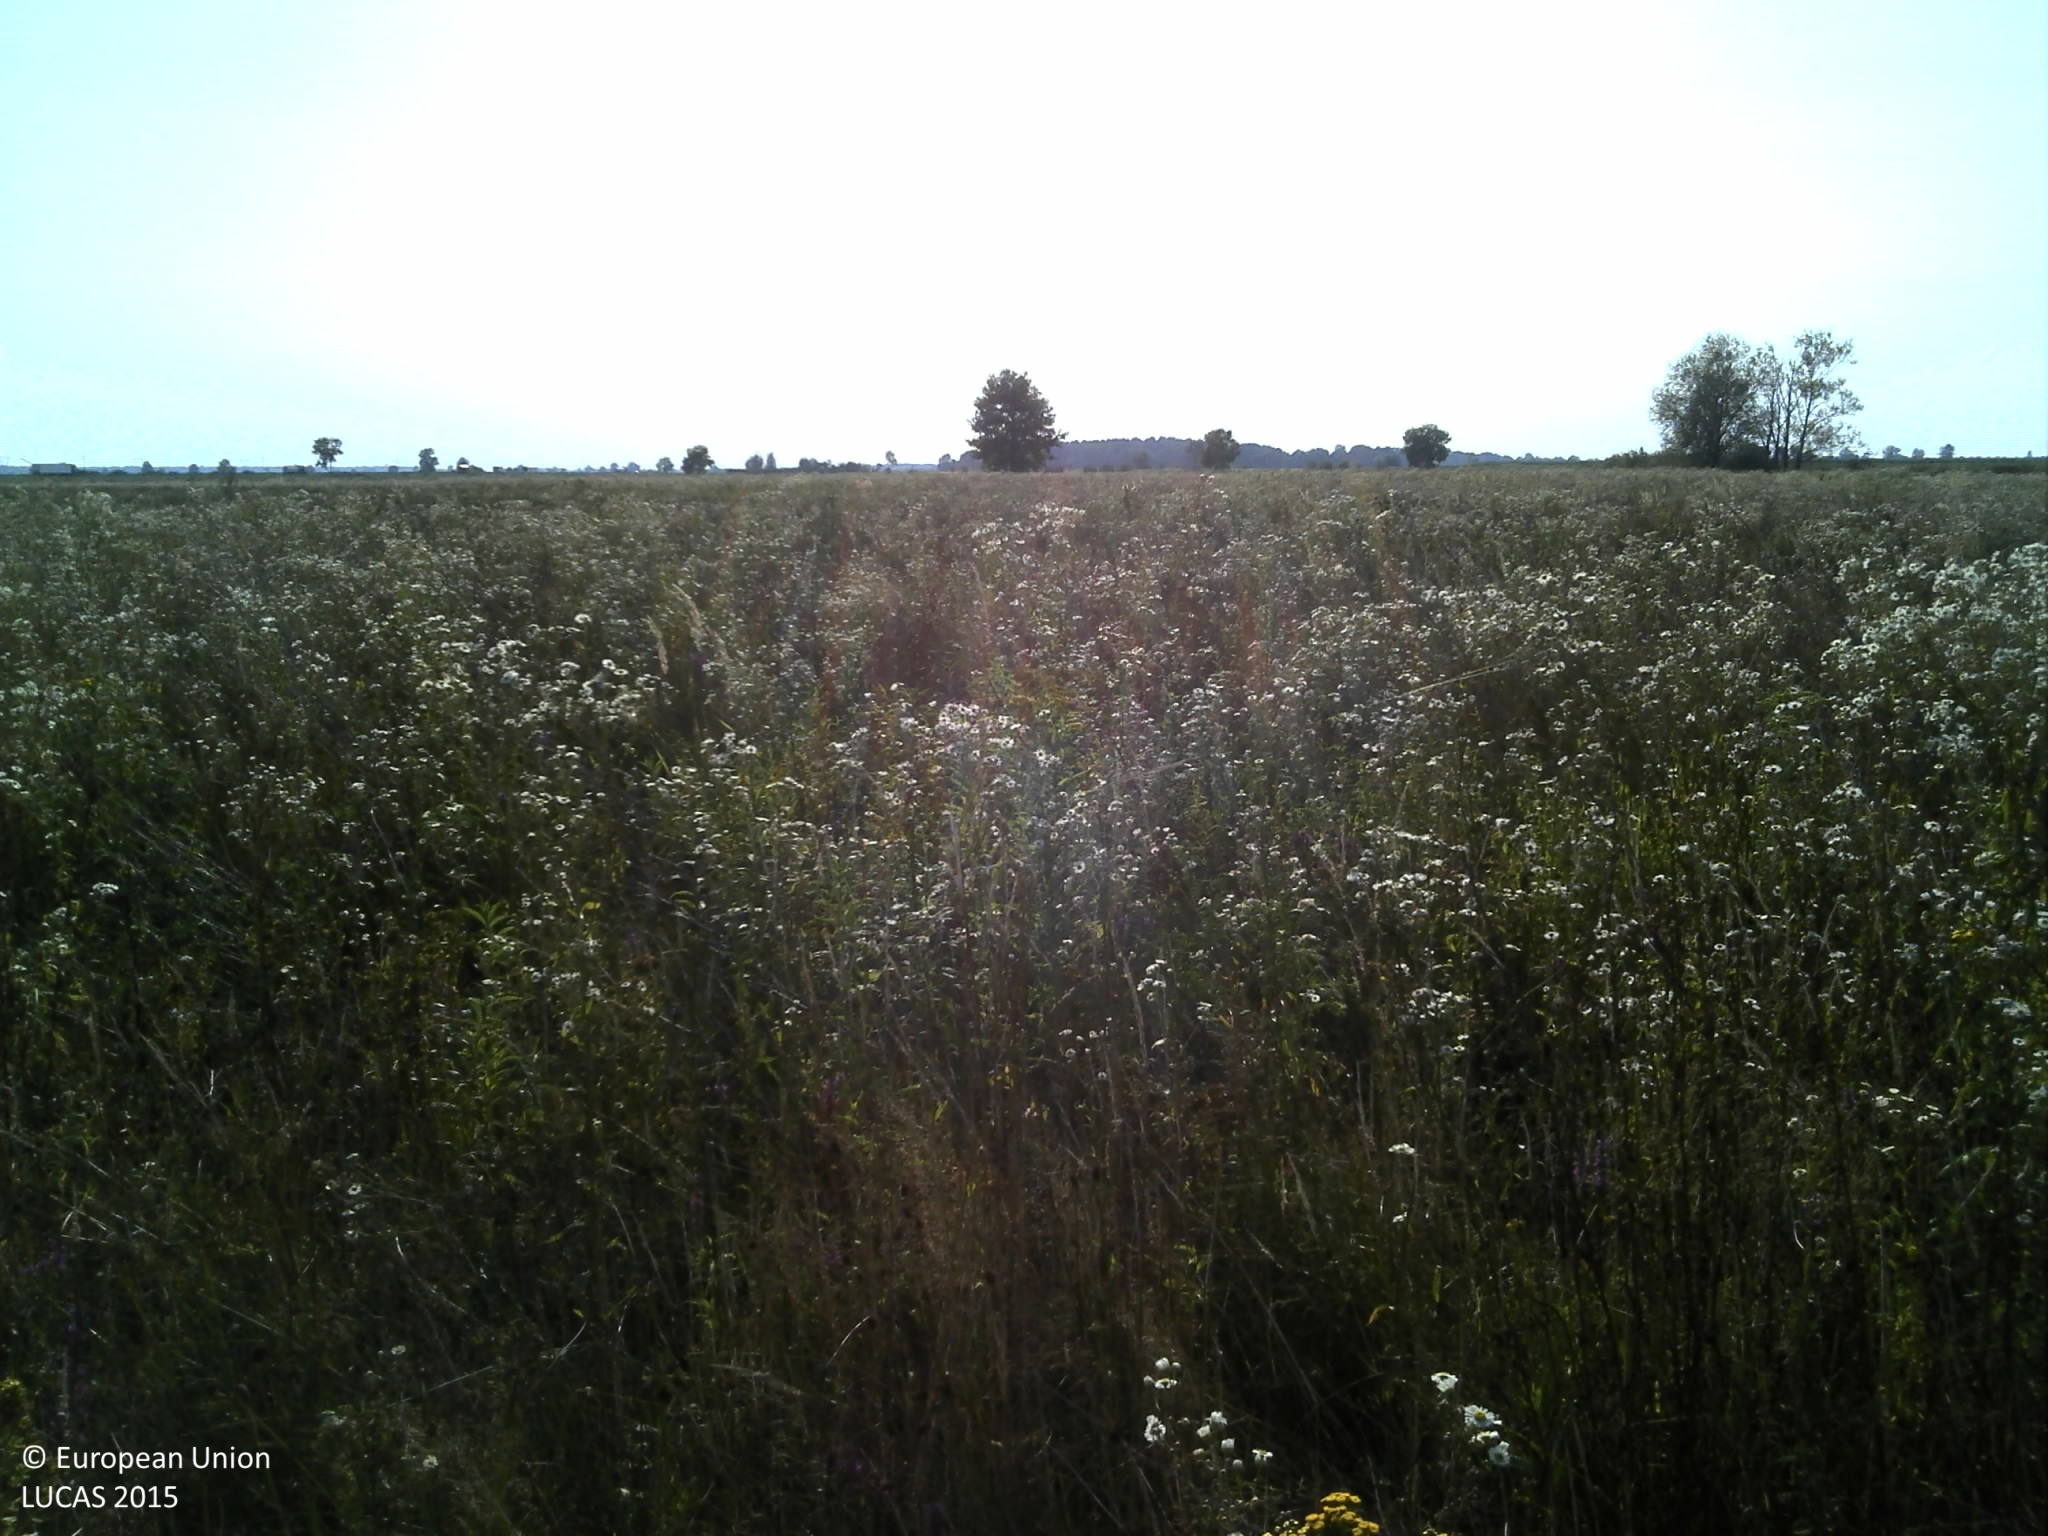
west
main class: Grassland
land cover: Spontaneously vegetated surfaces
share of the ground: > 75 %
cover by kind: herbaceous plants 100 %
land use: Fallow land
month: August
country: HR
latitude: 45.6862
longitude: 16.4572
